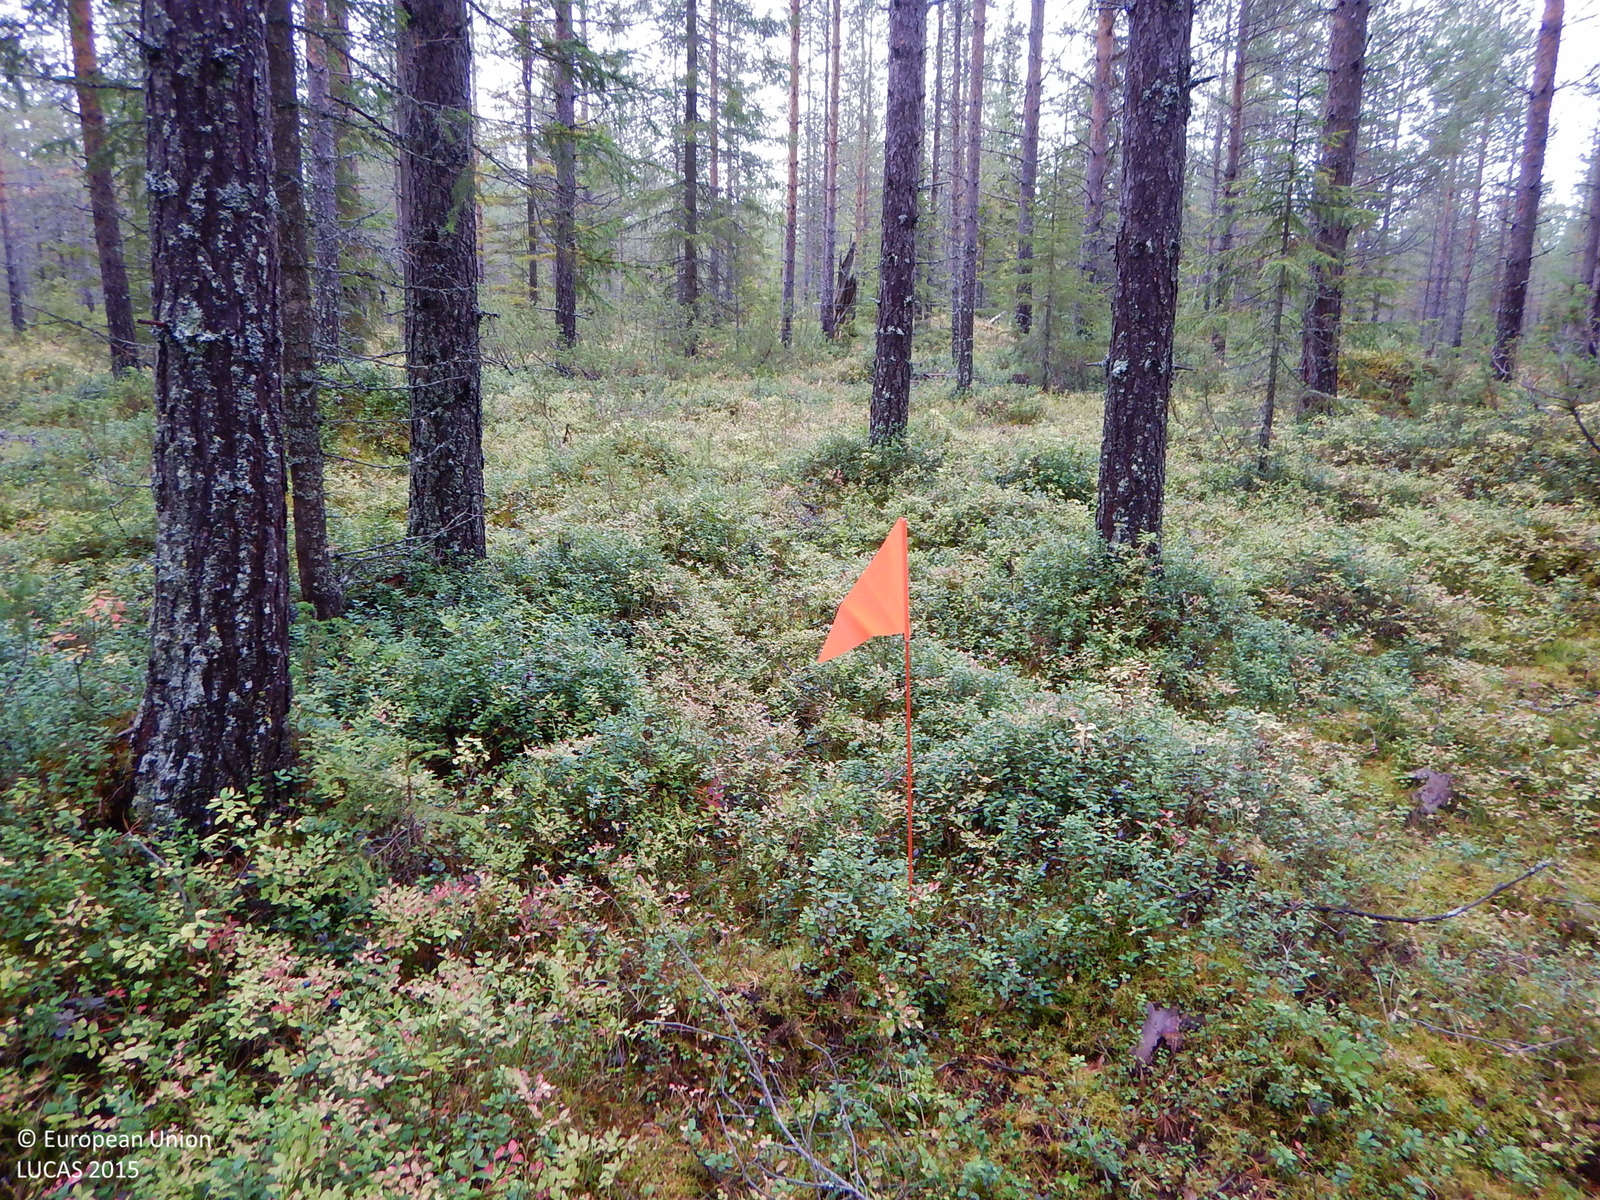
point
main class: Woodland
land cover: Pine dominated coniferous woodland
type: boreal forest
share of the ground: 50 - 75 %
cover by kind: coniferous forest trees 60 %, shrubs 20 %, lichens and mosses 20 %
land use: Forestry
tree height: > 5 m
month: September
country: SE
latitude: 65.1326
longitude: 19.1930
